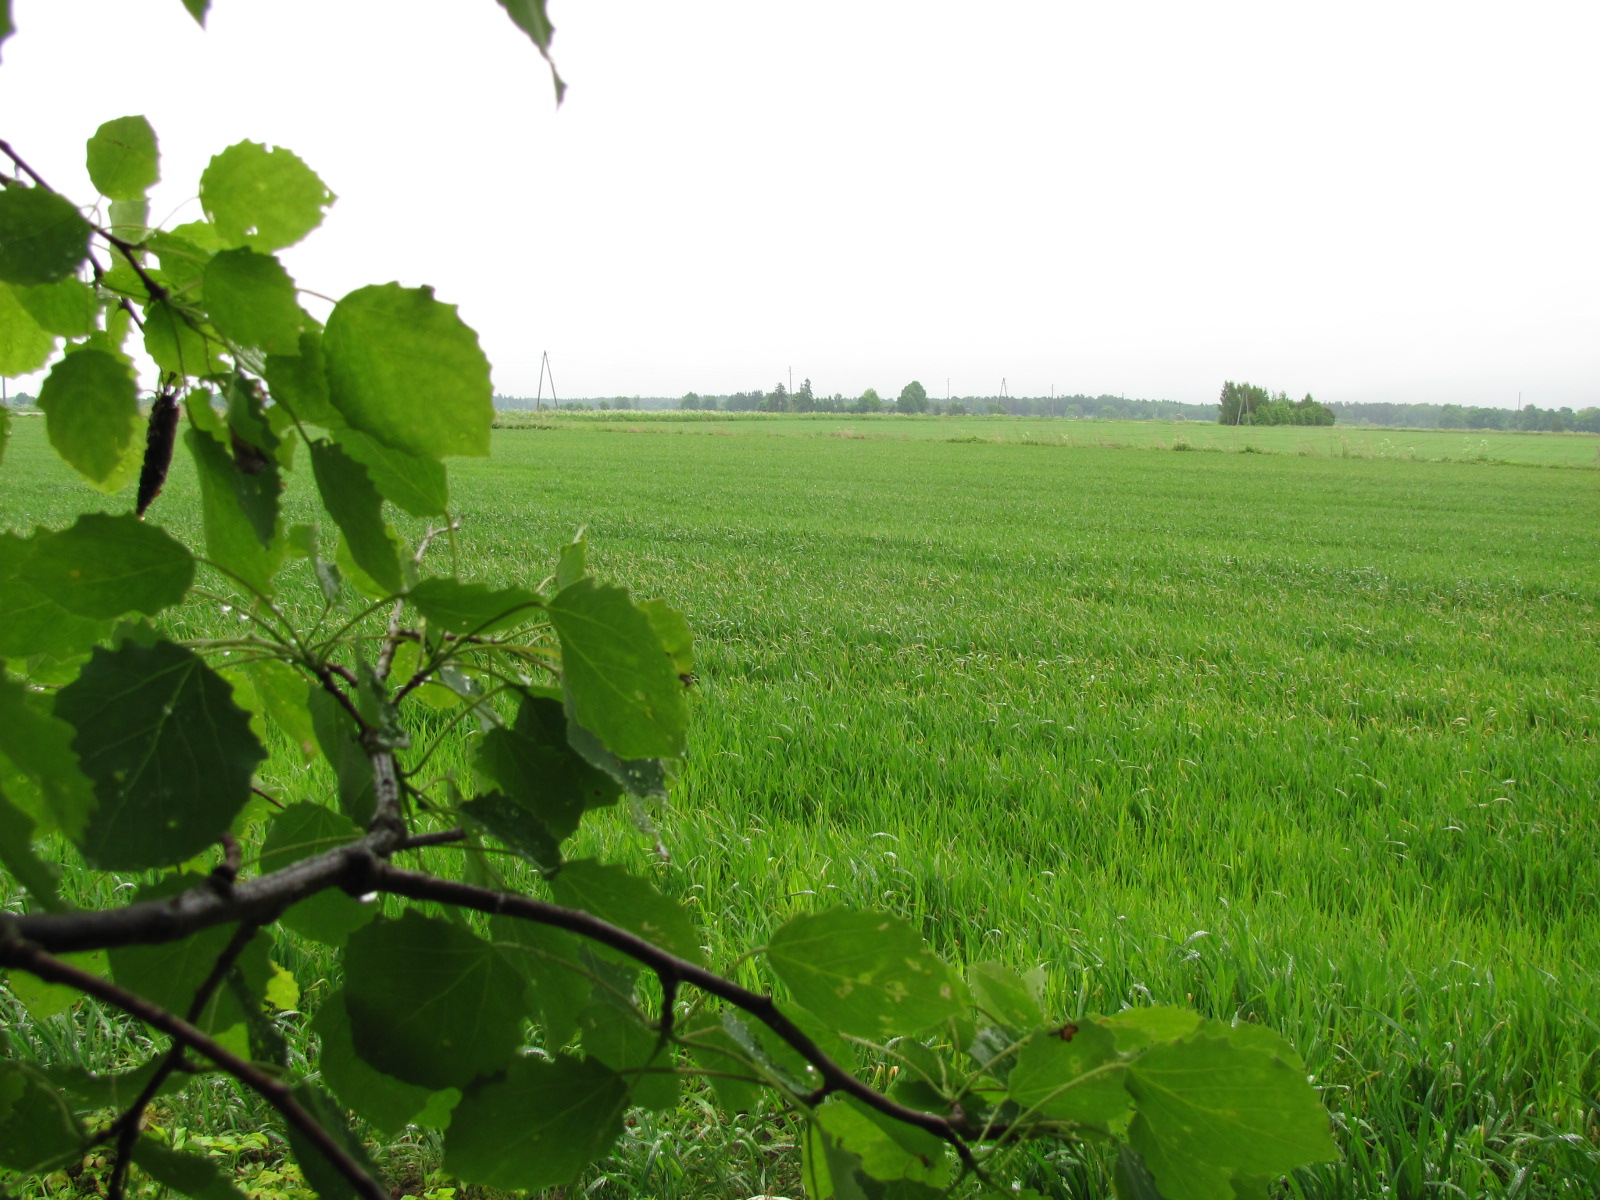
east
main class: Woodland
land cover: Broadleaved woodland
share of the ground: > 75 %
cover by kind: broadleaved forest trees 100 %
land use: Residential
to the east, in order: Broadleaved woodland; Spontaneously vegetated surfaces; Common wheat; Shruby margins; Paved roads, cycling and walking lanes; Grassland without tree/shrub cover; Triticale; Grass margins; Paved roads, cycling and walking lanes; Grass margins; Ditches and canals; Common wheat
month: June
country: LV
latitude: 56.5951
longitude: 24.2425
